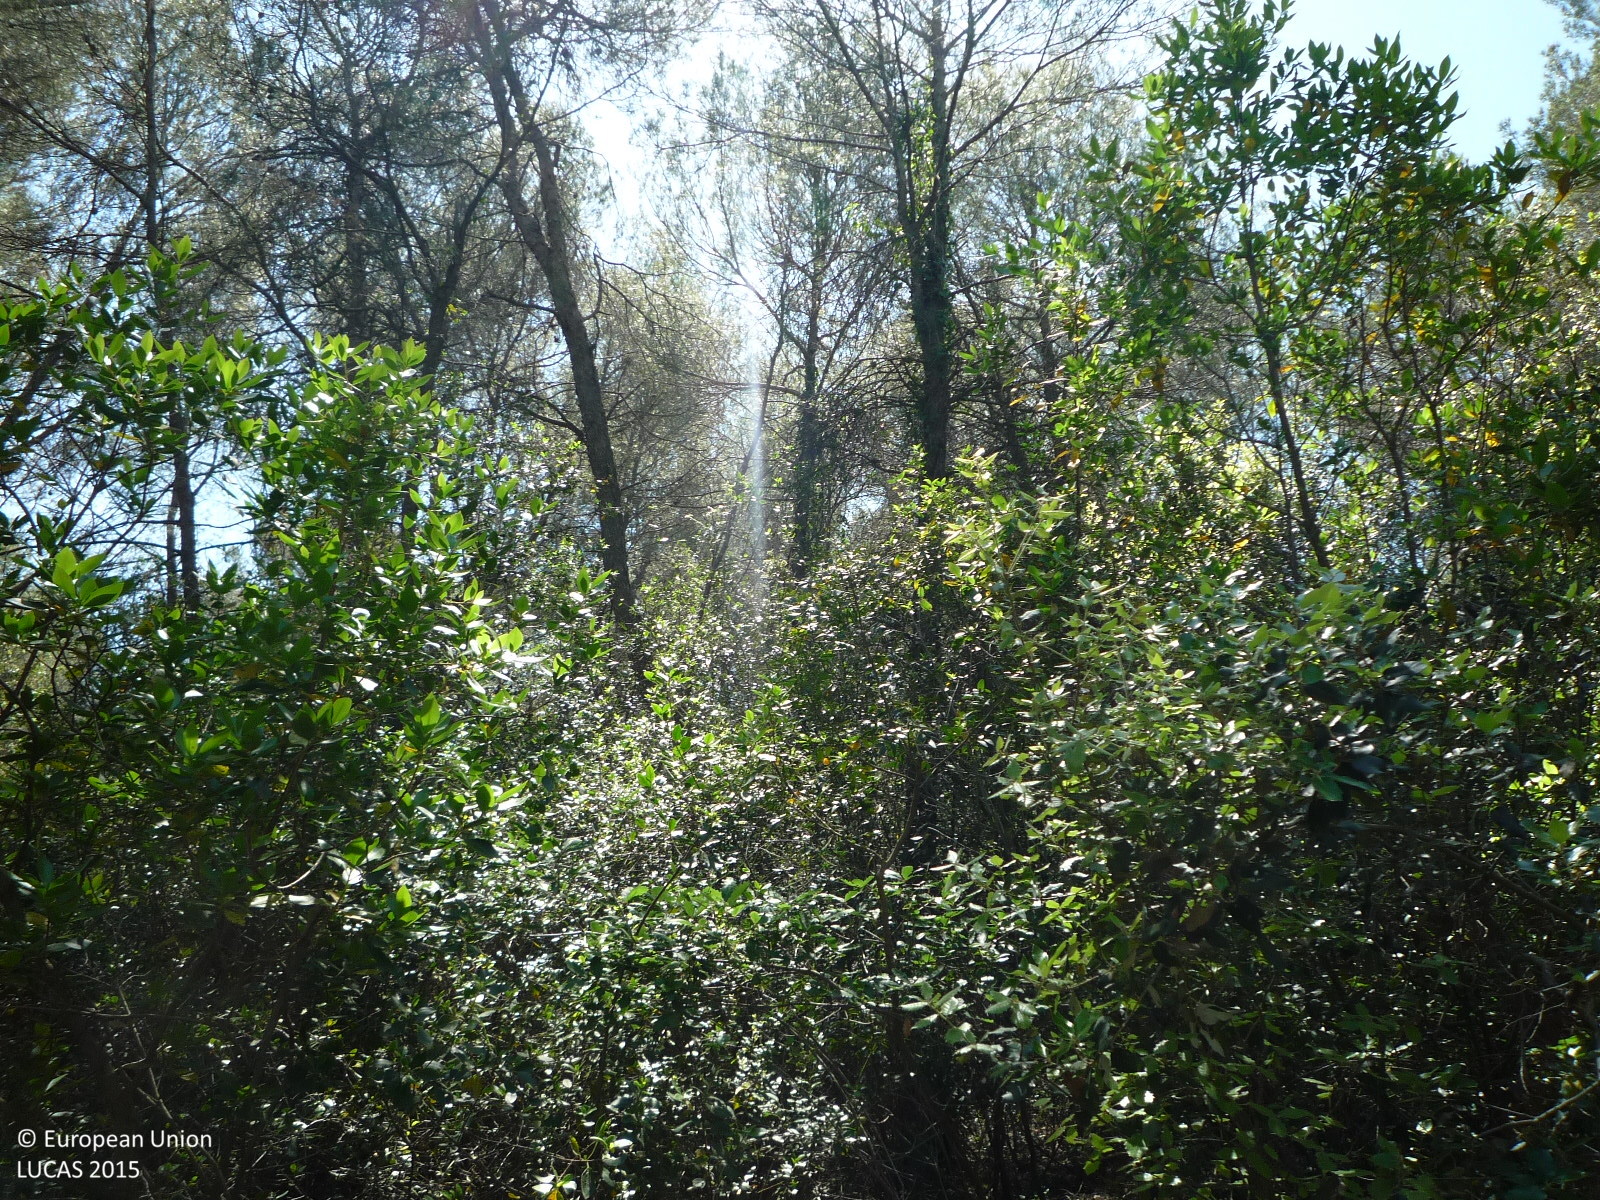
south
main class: Woodland
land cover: Pine dominated mixed woodland
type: coniferous forest of the mediterranean region
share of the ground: > 75 %
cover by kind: coniferous forest trees 75 %, broadleaved forest trees 25 %
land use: Semi-natural and natural areas not in use
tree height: > 5 m
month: May
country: ES
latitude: 41.5084
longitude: 2.0737
